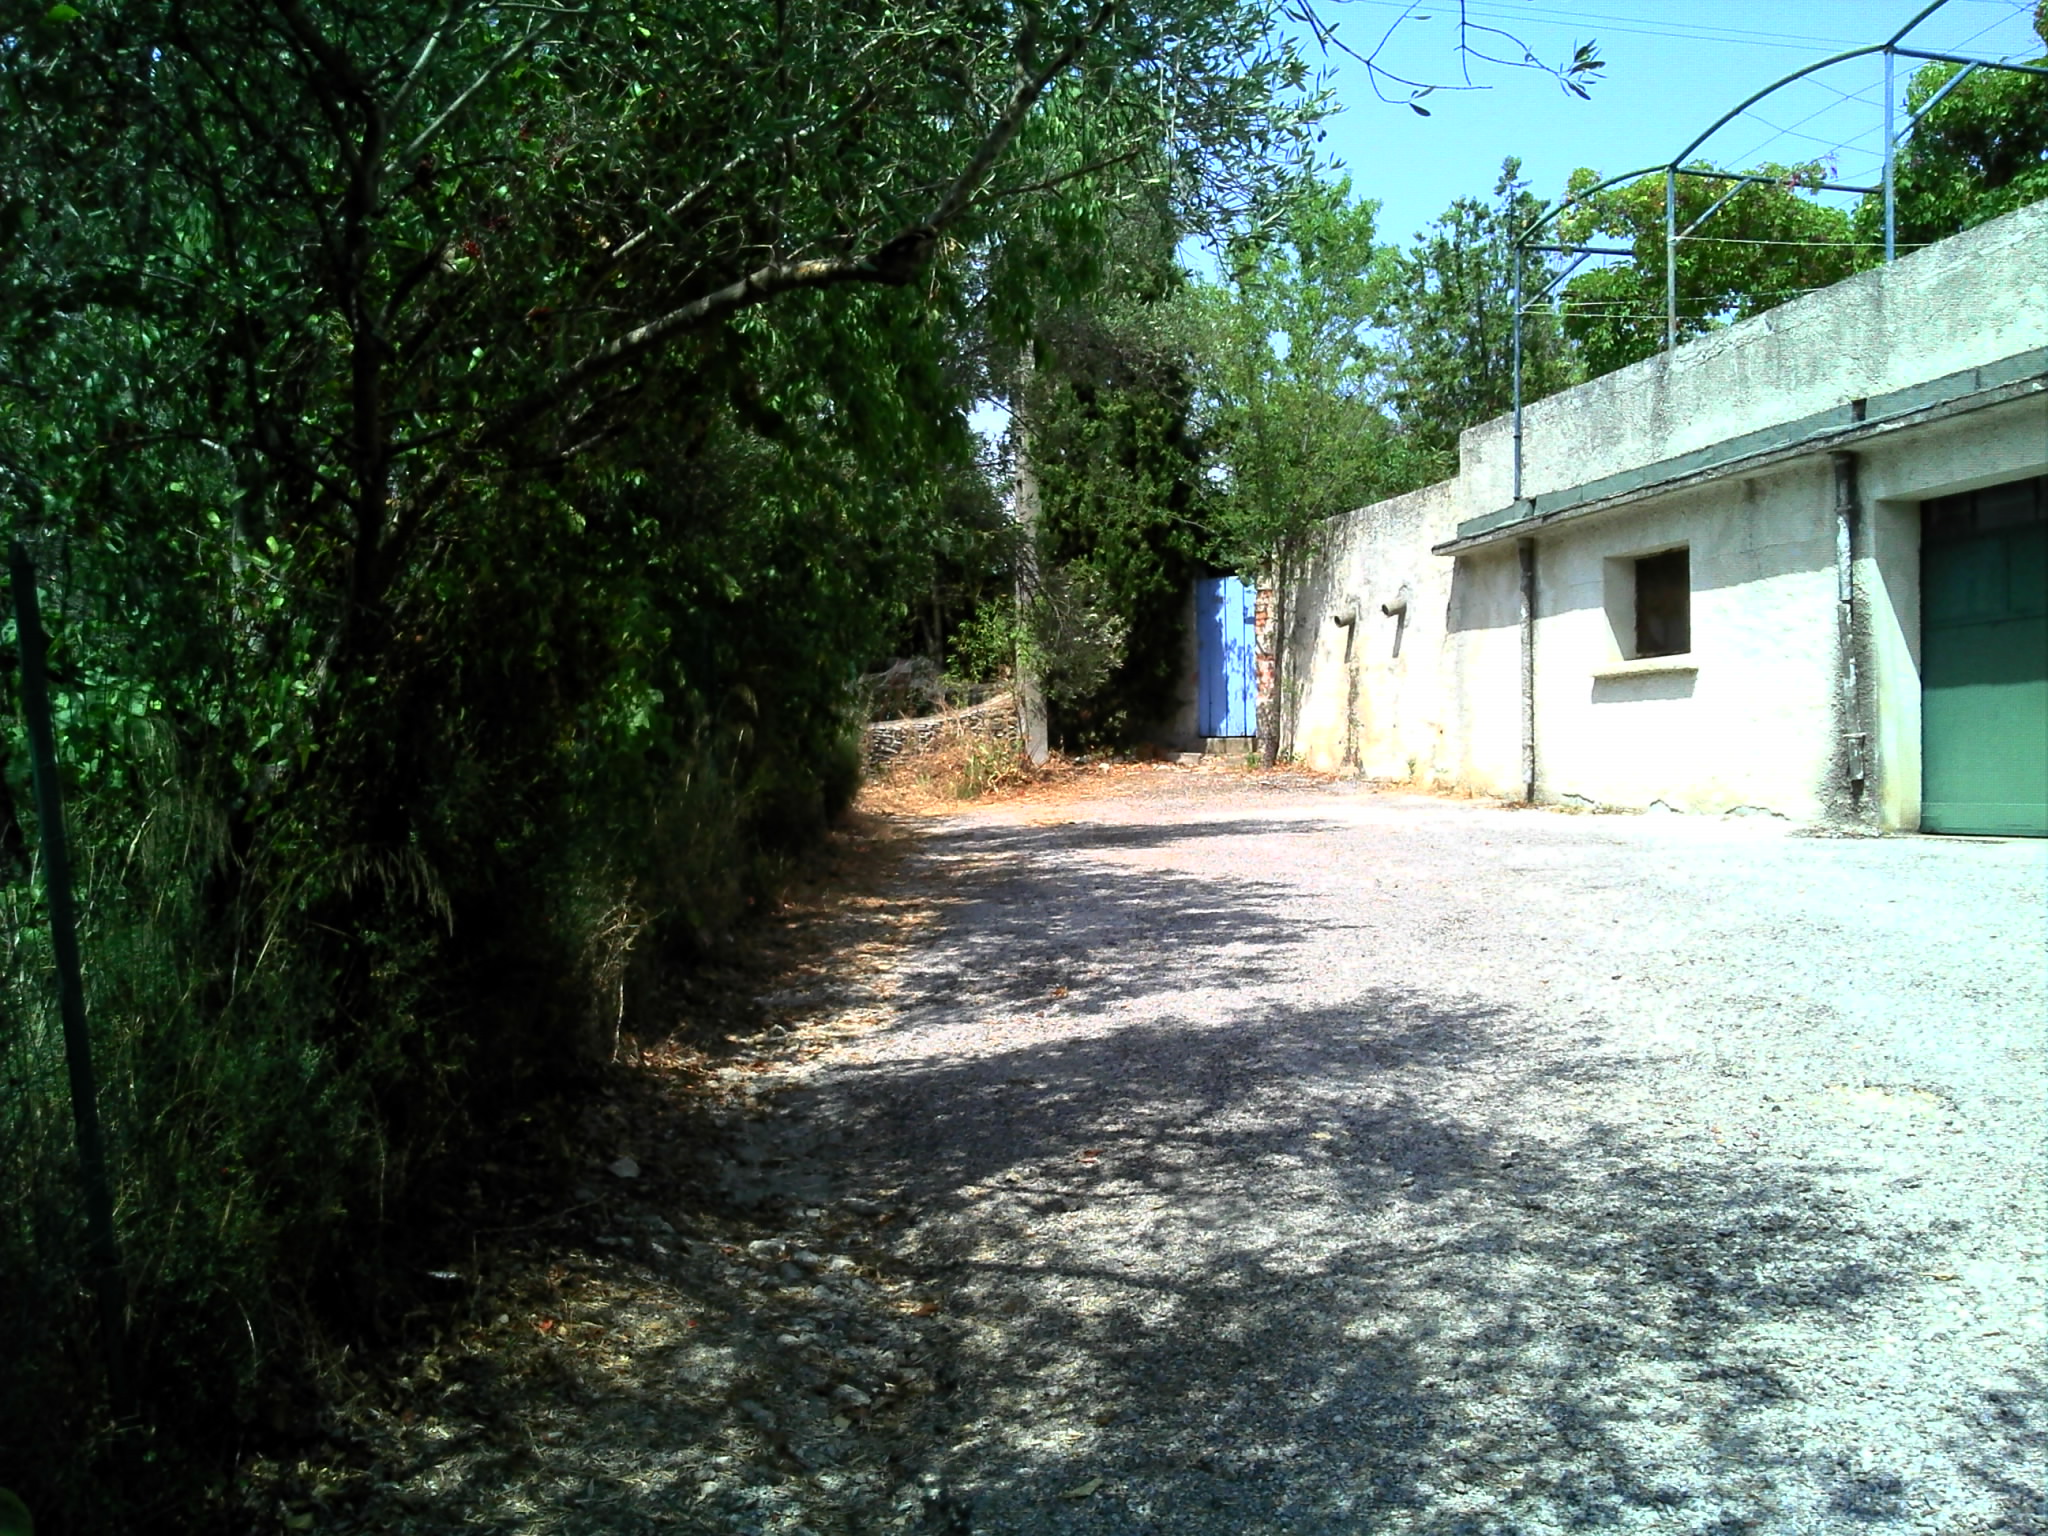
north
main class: Woodland
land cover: Pine dominated mixed woodland
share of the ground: 50 - 75 %
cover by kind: coniferous forest trees 30 %, broadleaved forest trees 30 %, herbaceous plants 20 %, consolidated bare surface 20 %
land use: Residential
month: August
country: FR
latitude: 43.8544
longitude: 4.3732
